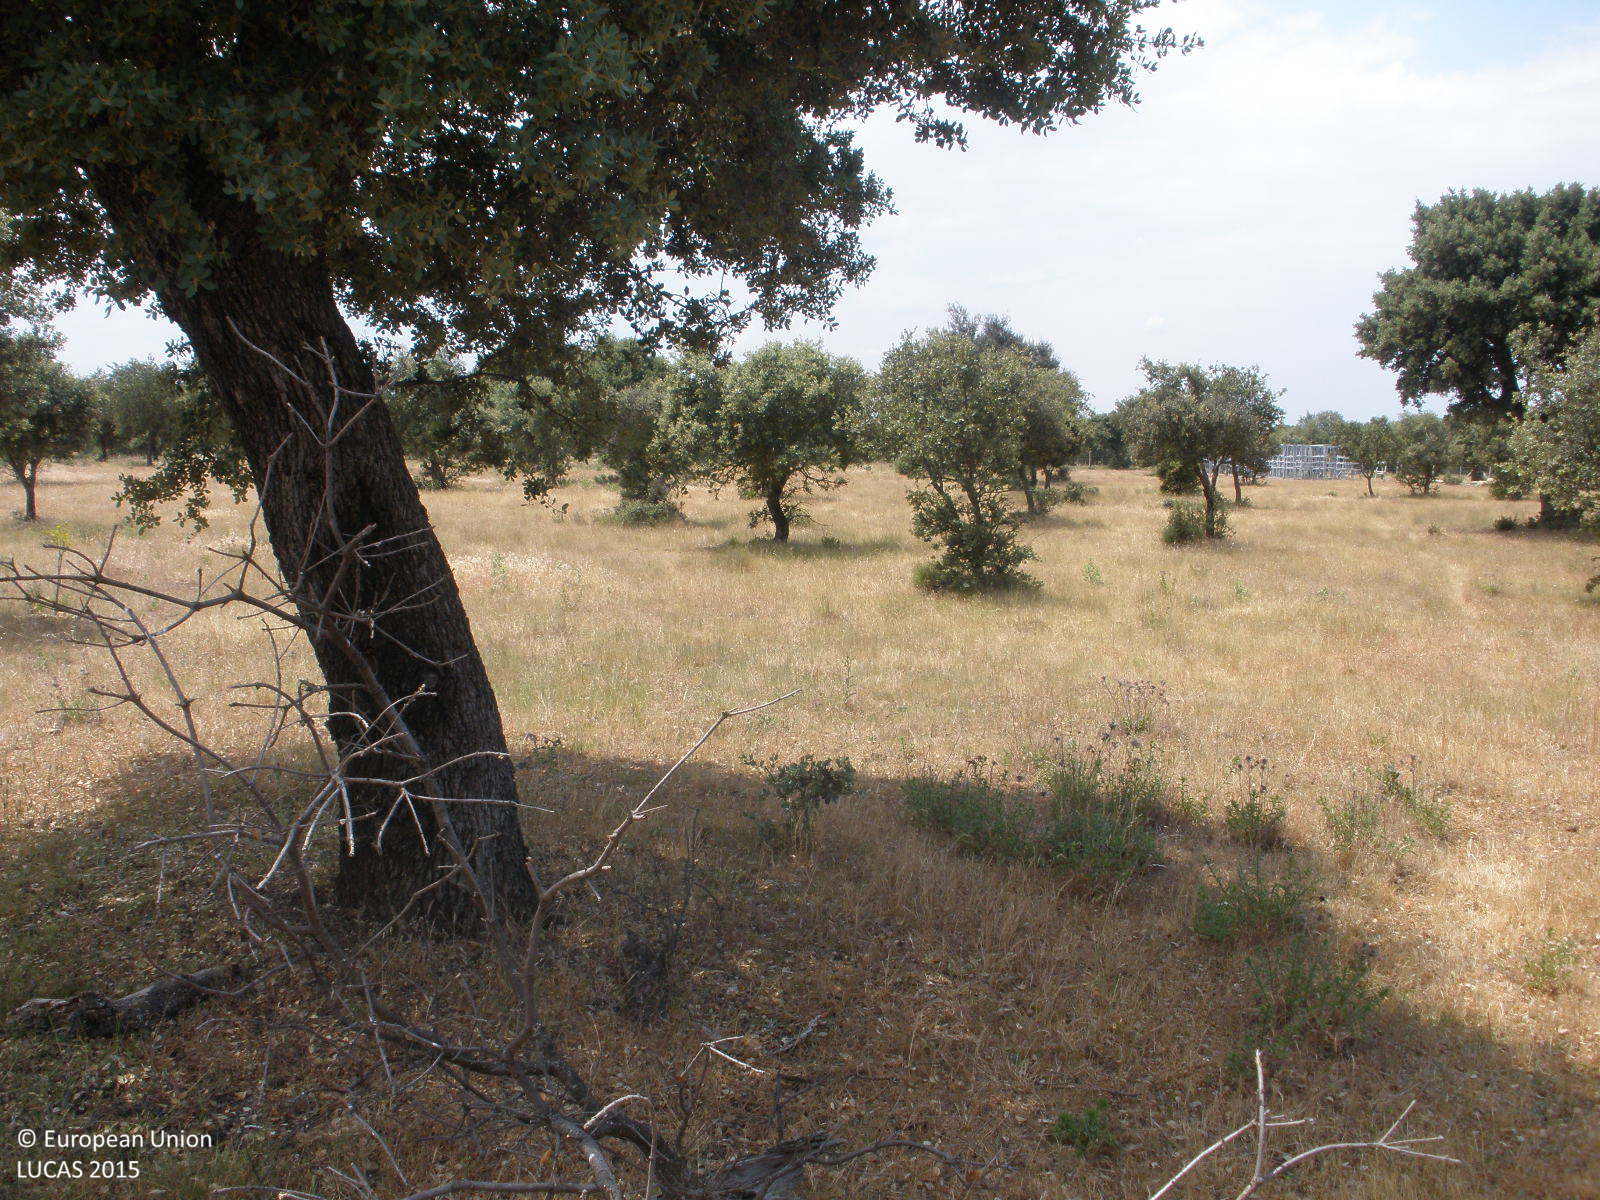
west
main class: Woodland
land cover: Broadleaved woodland
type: broadleaved evergreen forest
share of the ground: 25 - 50 %
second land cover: Grassland without tree/shrub cover
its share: > 75 %
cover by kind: herbaceous plants 70 %, broadleaved forest trees 30 %
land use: Agriculture (excluding fallow land and kitchen gardens)
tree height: > 5 m
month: June
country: ES
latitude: 40.6293
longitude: -6.2696
